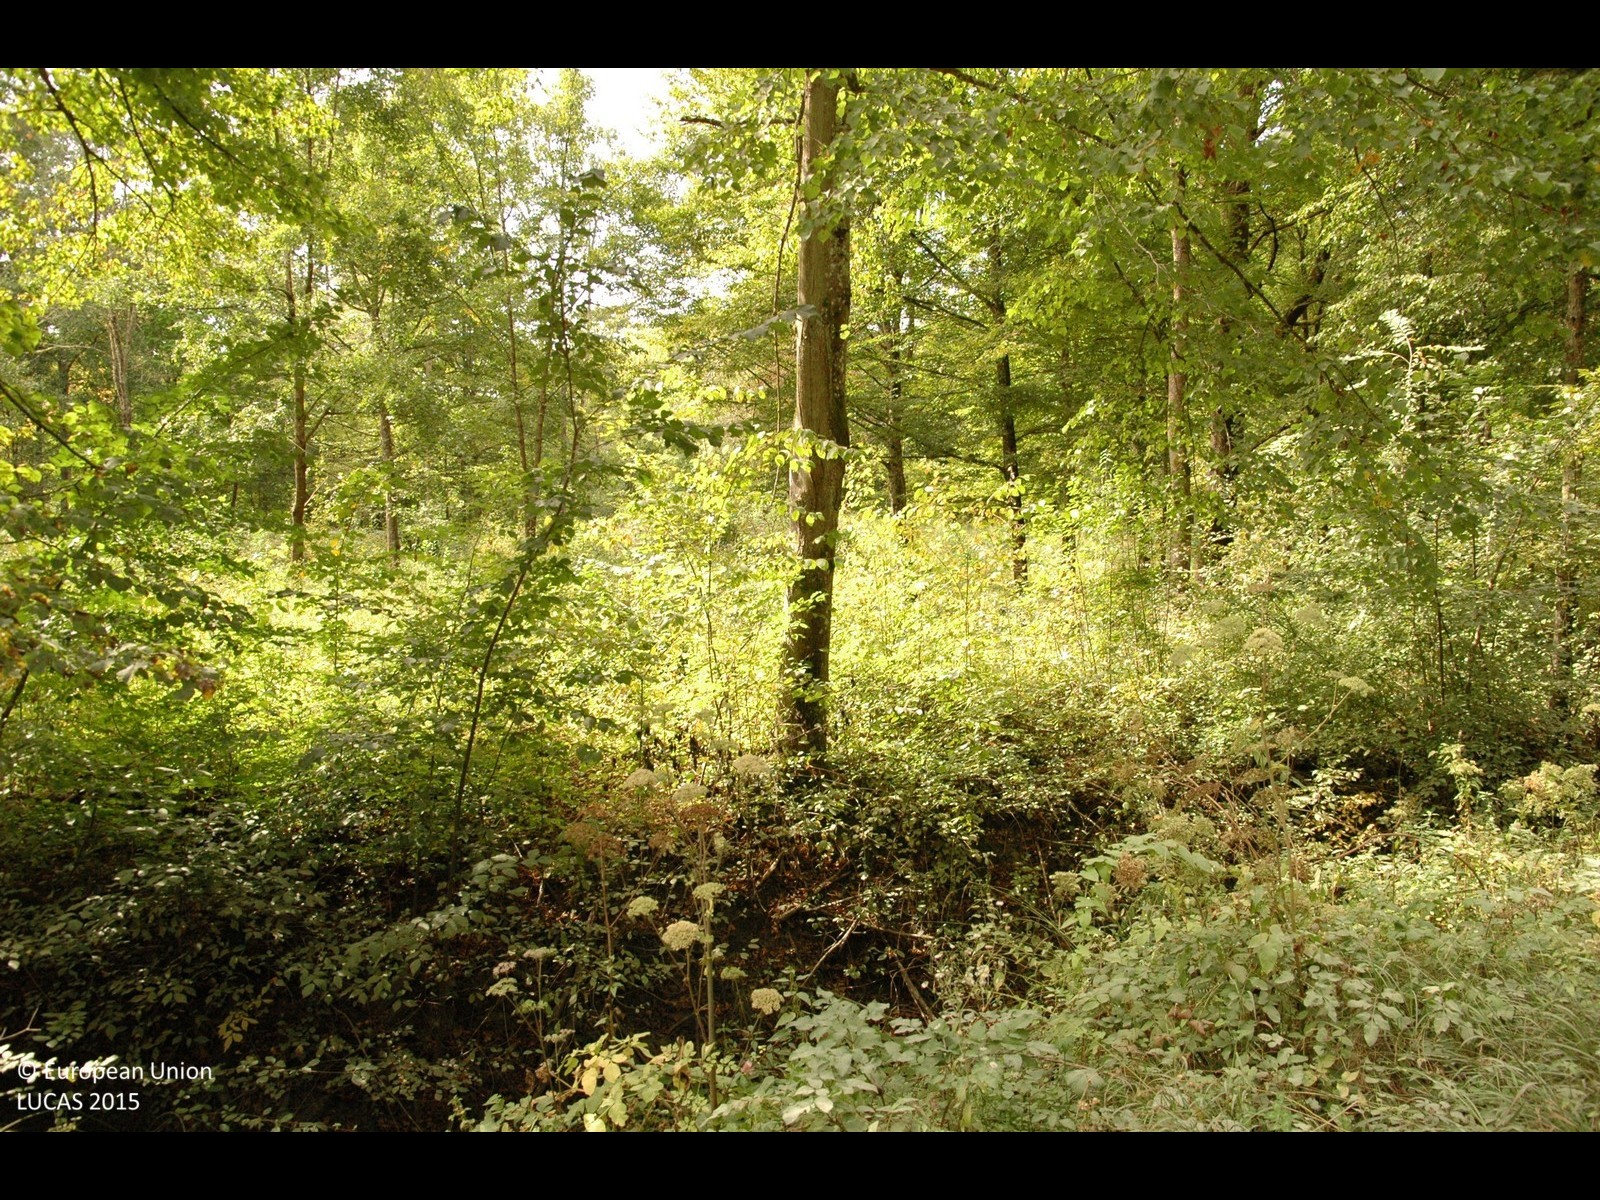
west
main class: Woodland
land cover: Broadleaved woodland
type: mesophytic deciduous forest
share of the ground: > 75 %
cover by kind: broadleaved forest trees 100 %
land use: Forestry
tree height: > 5 m
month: September
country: HR
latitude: 45.6088
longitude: 16.2424
